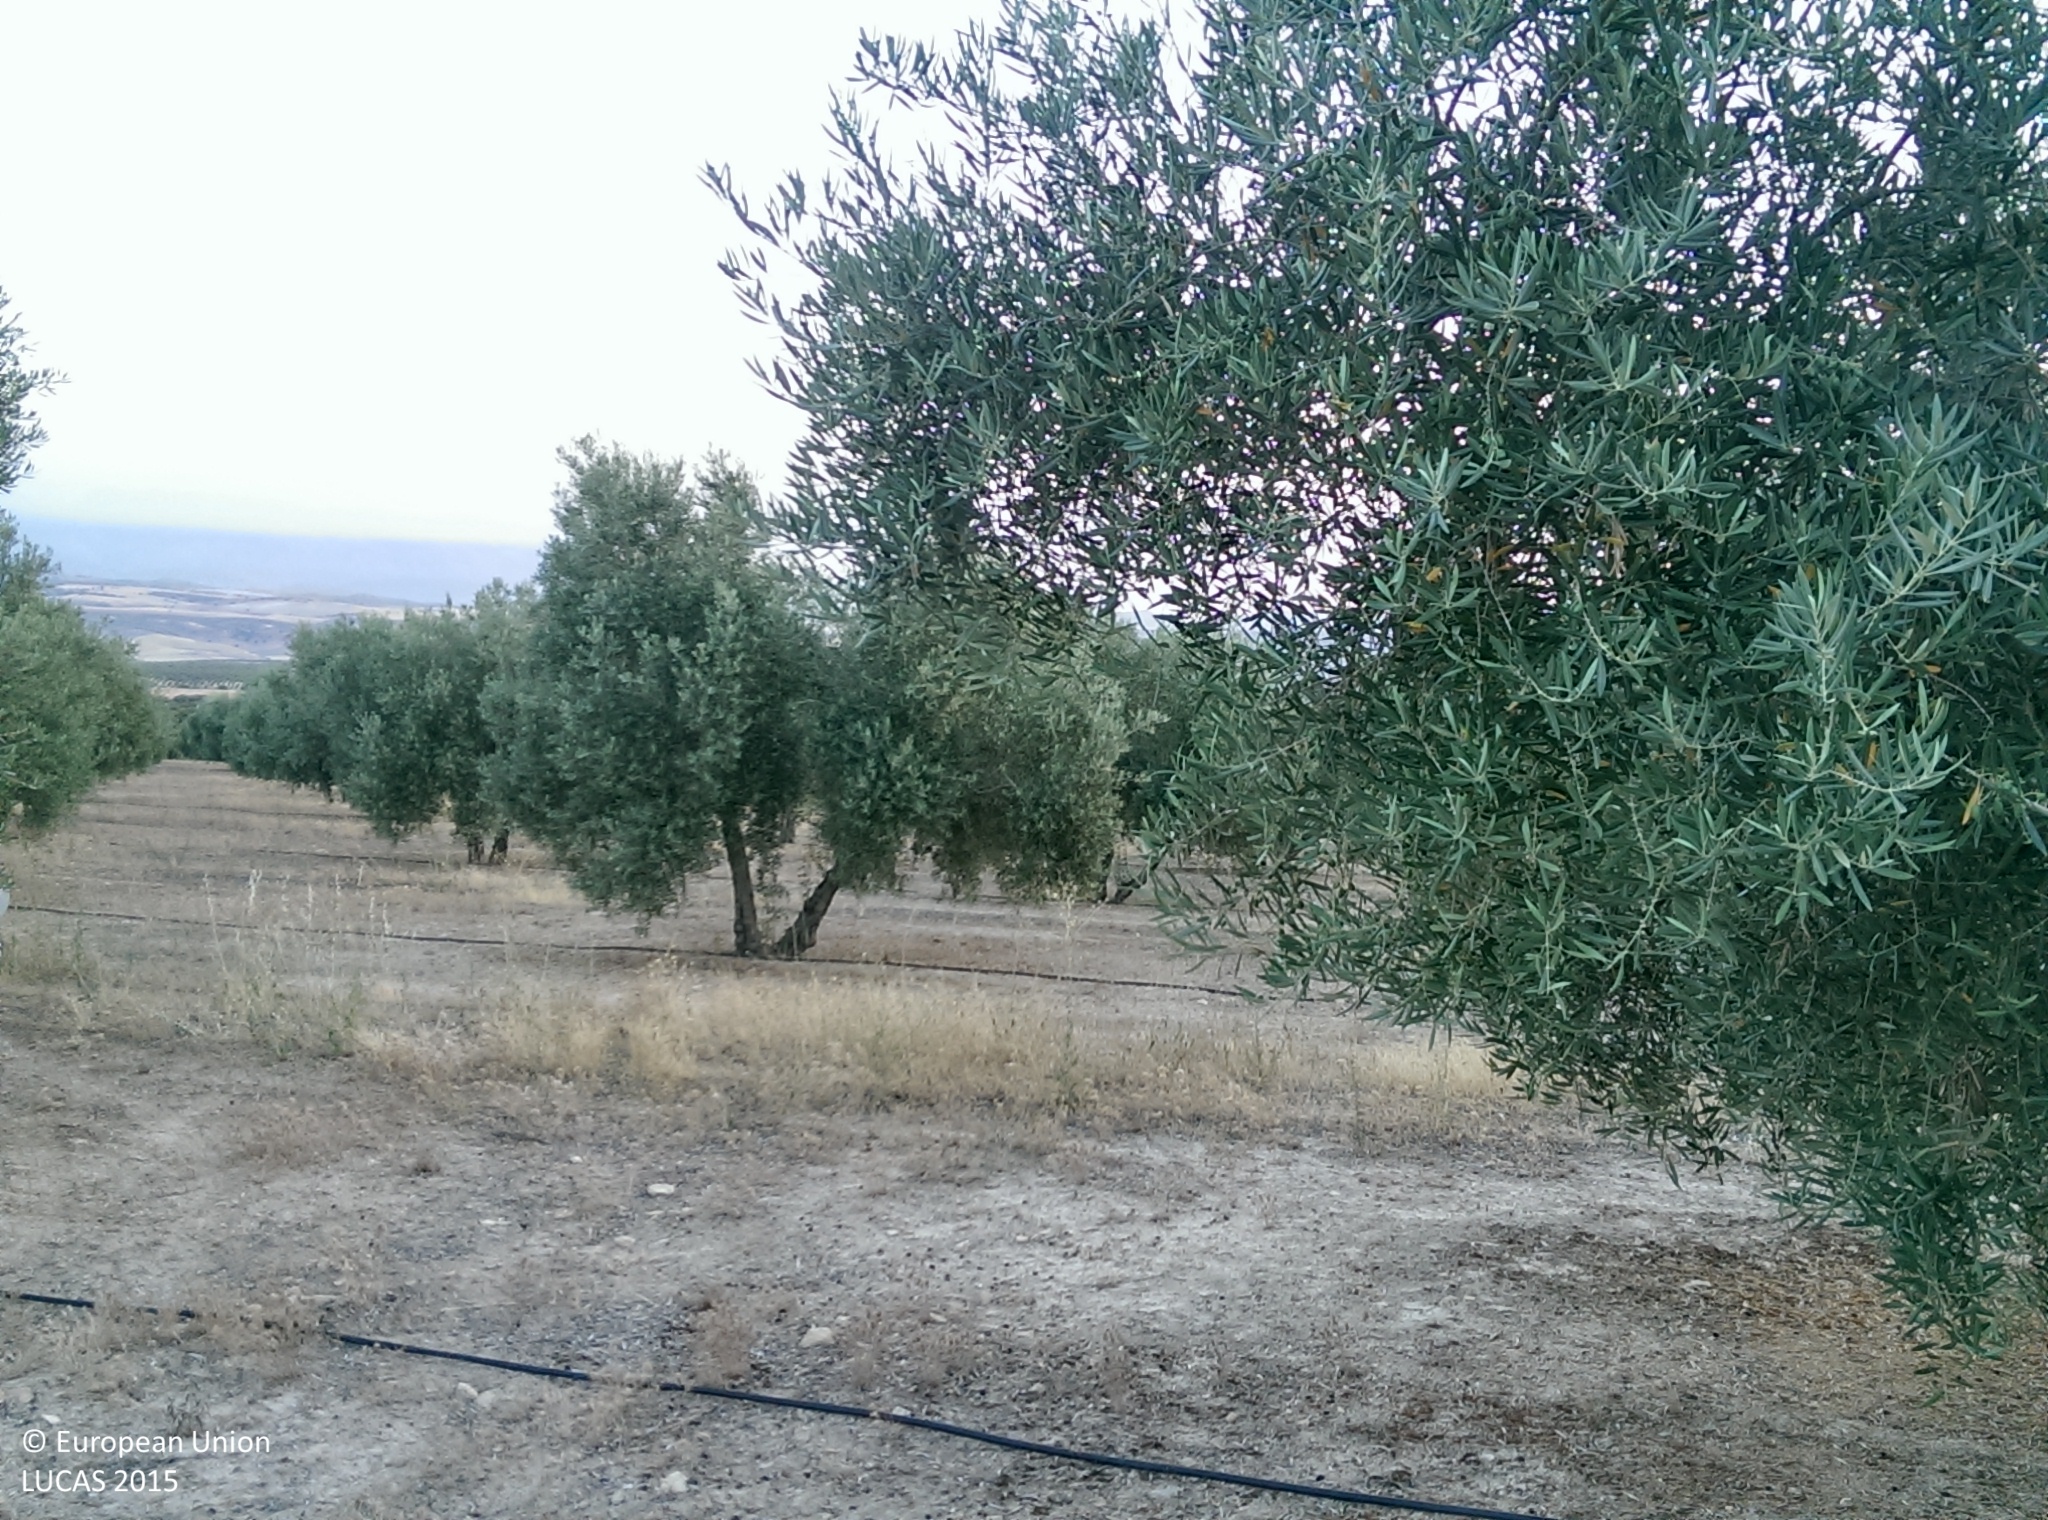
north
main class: Cropland
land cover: Olive groves
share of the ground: 25 - 50 %
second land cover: Spontaneously vegetated surfaces
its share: 10 - 25 %
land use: Agriculture (excluding fallow land and kitchen gardens)
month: July
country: ES
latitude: 37.5378
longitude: -3.3355
